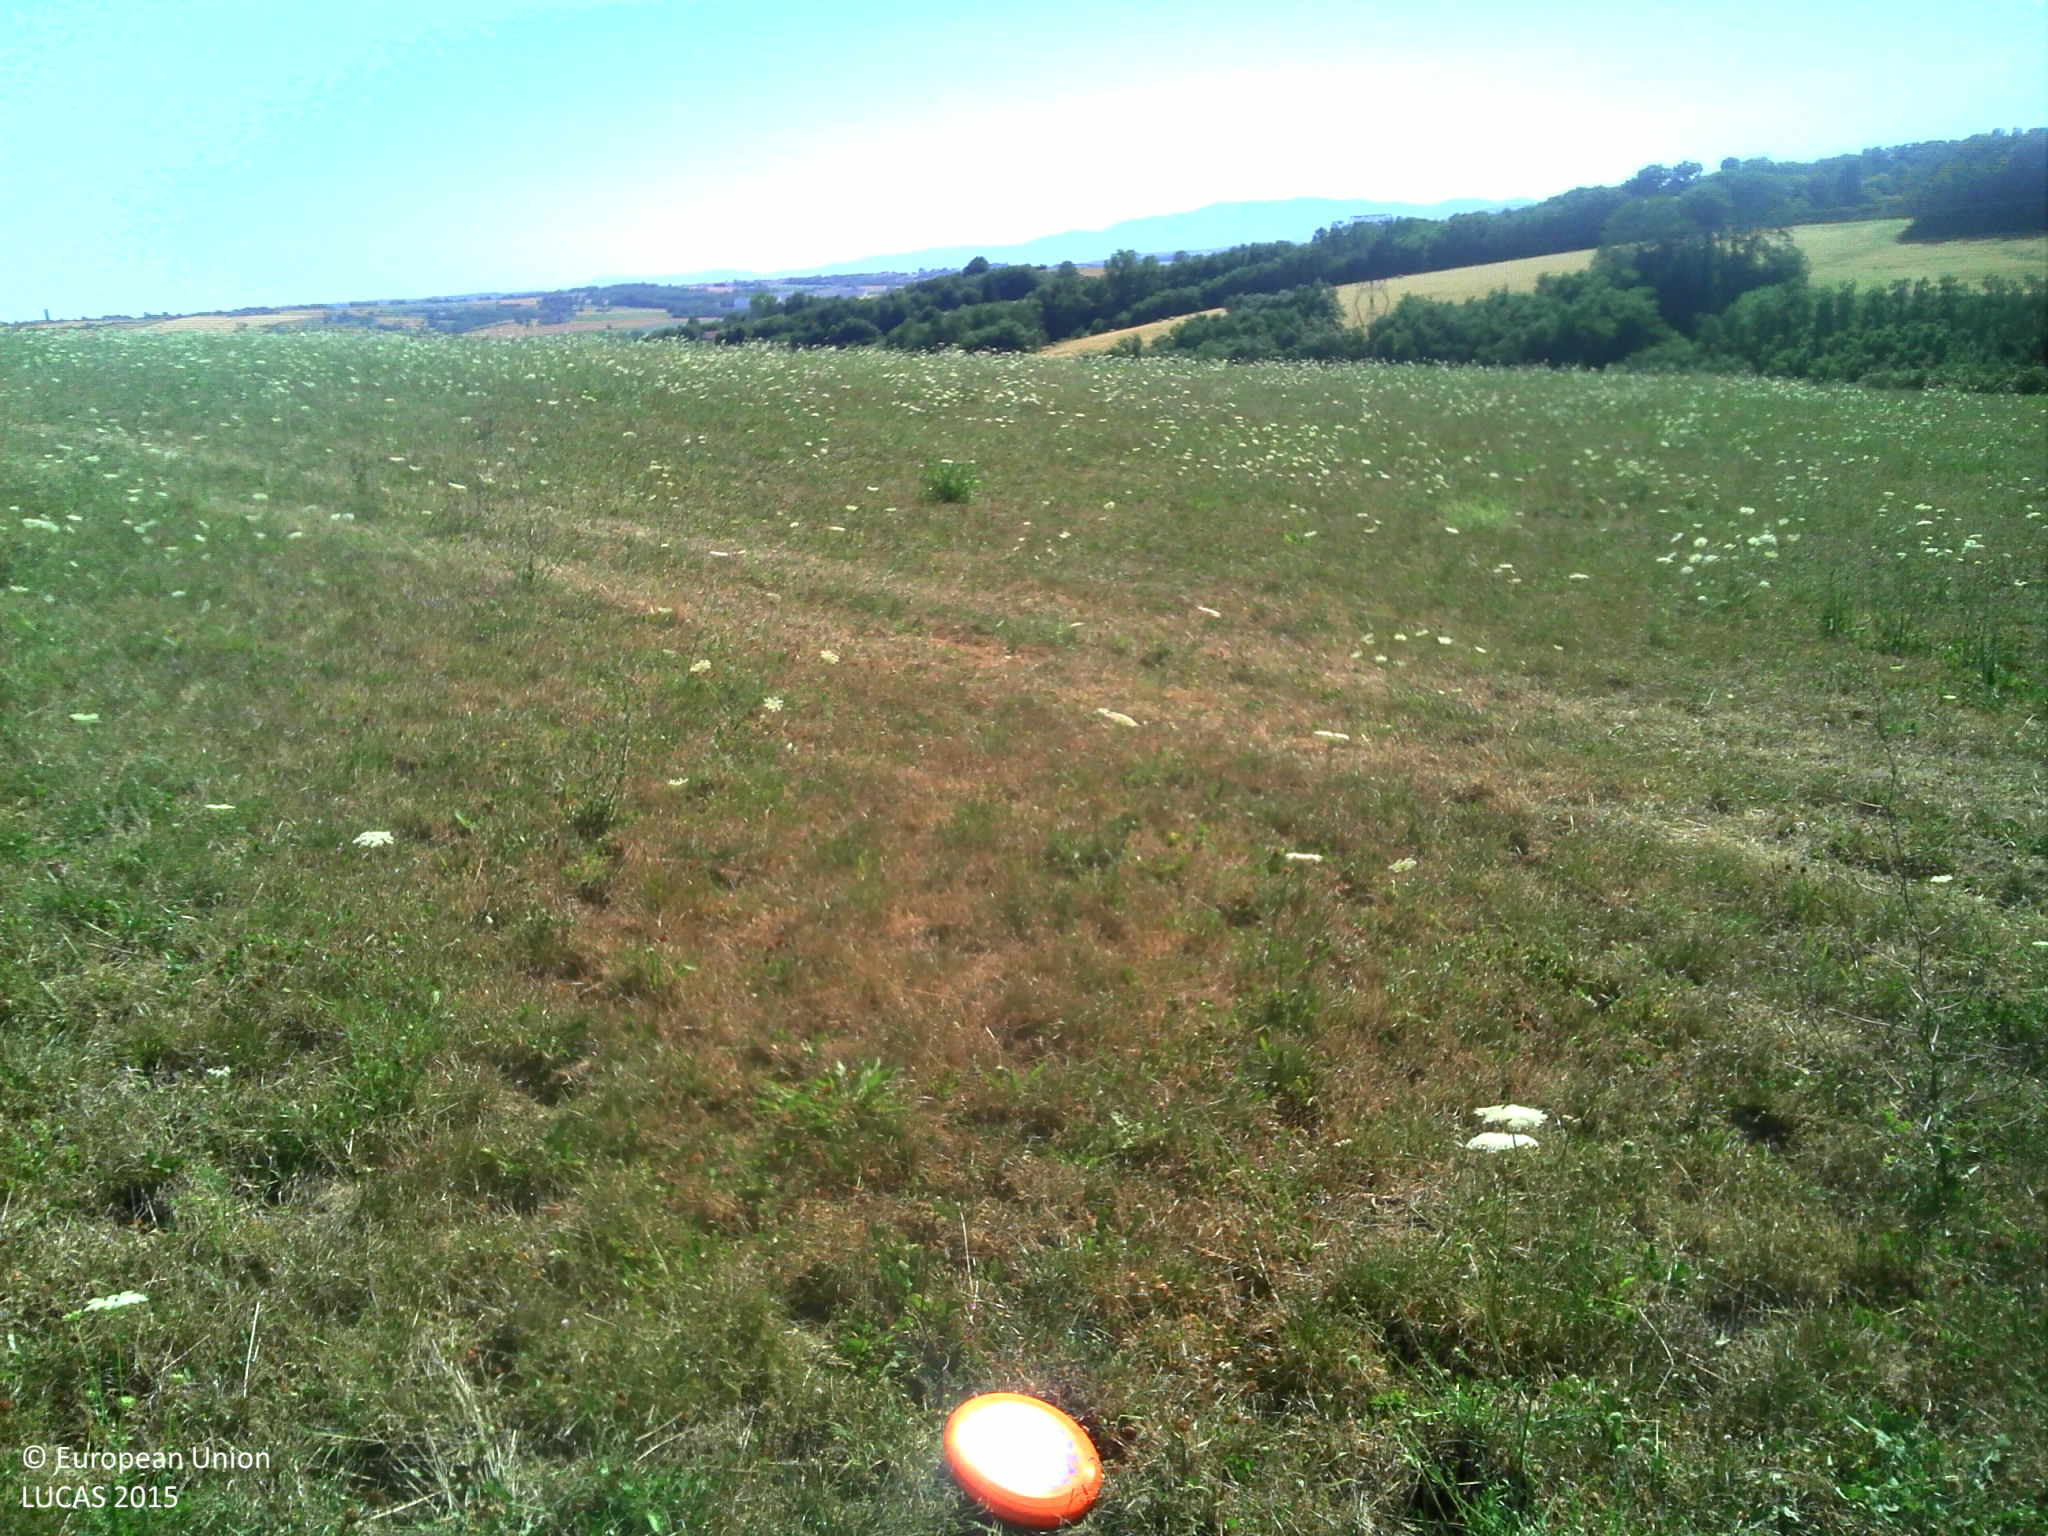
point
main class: Grassland
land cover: Grassland without tree/shrub cover
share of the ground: > 75 %
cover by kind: herbaceous plants 100 %
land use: Agriculture (excluding fallow land and kitchen gardens)
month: July
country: FR
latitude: 45.6010
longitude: 4.9656
